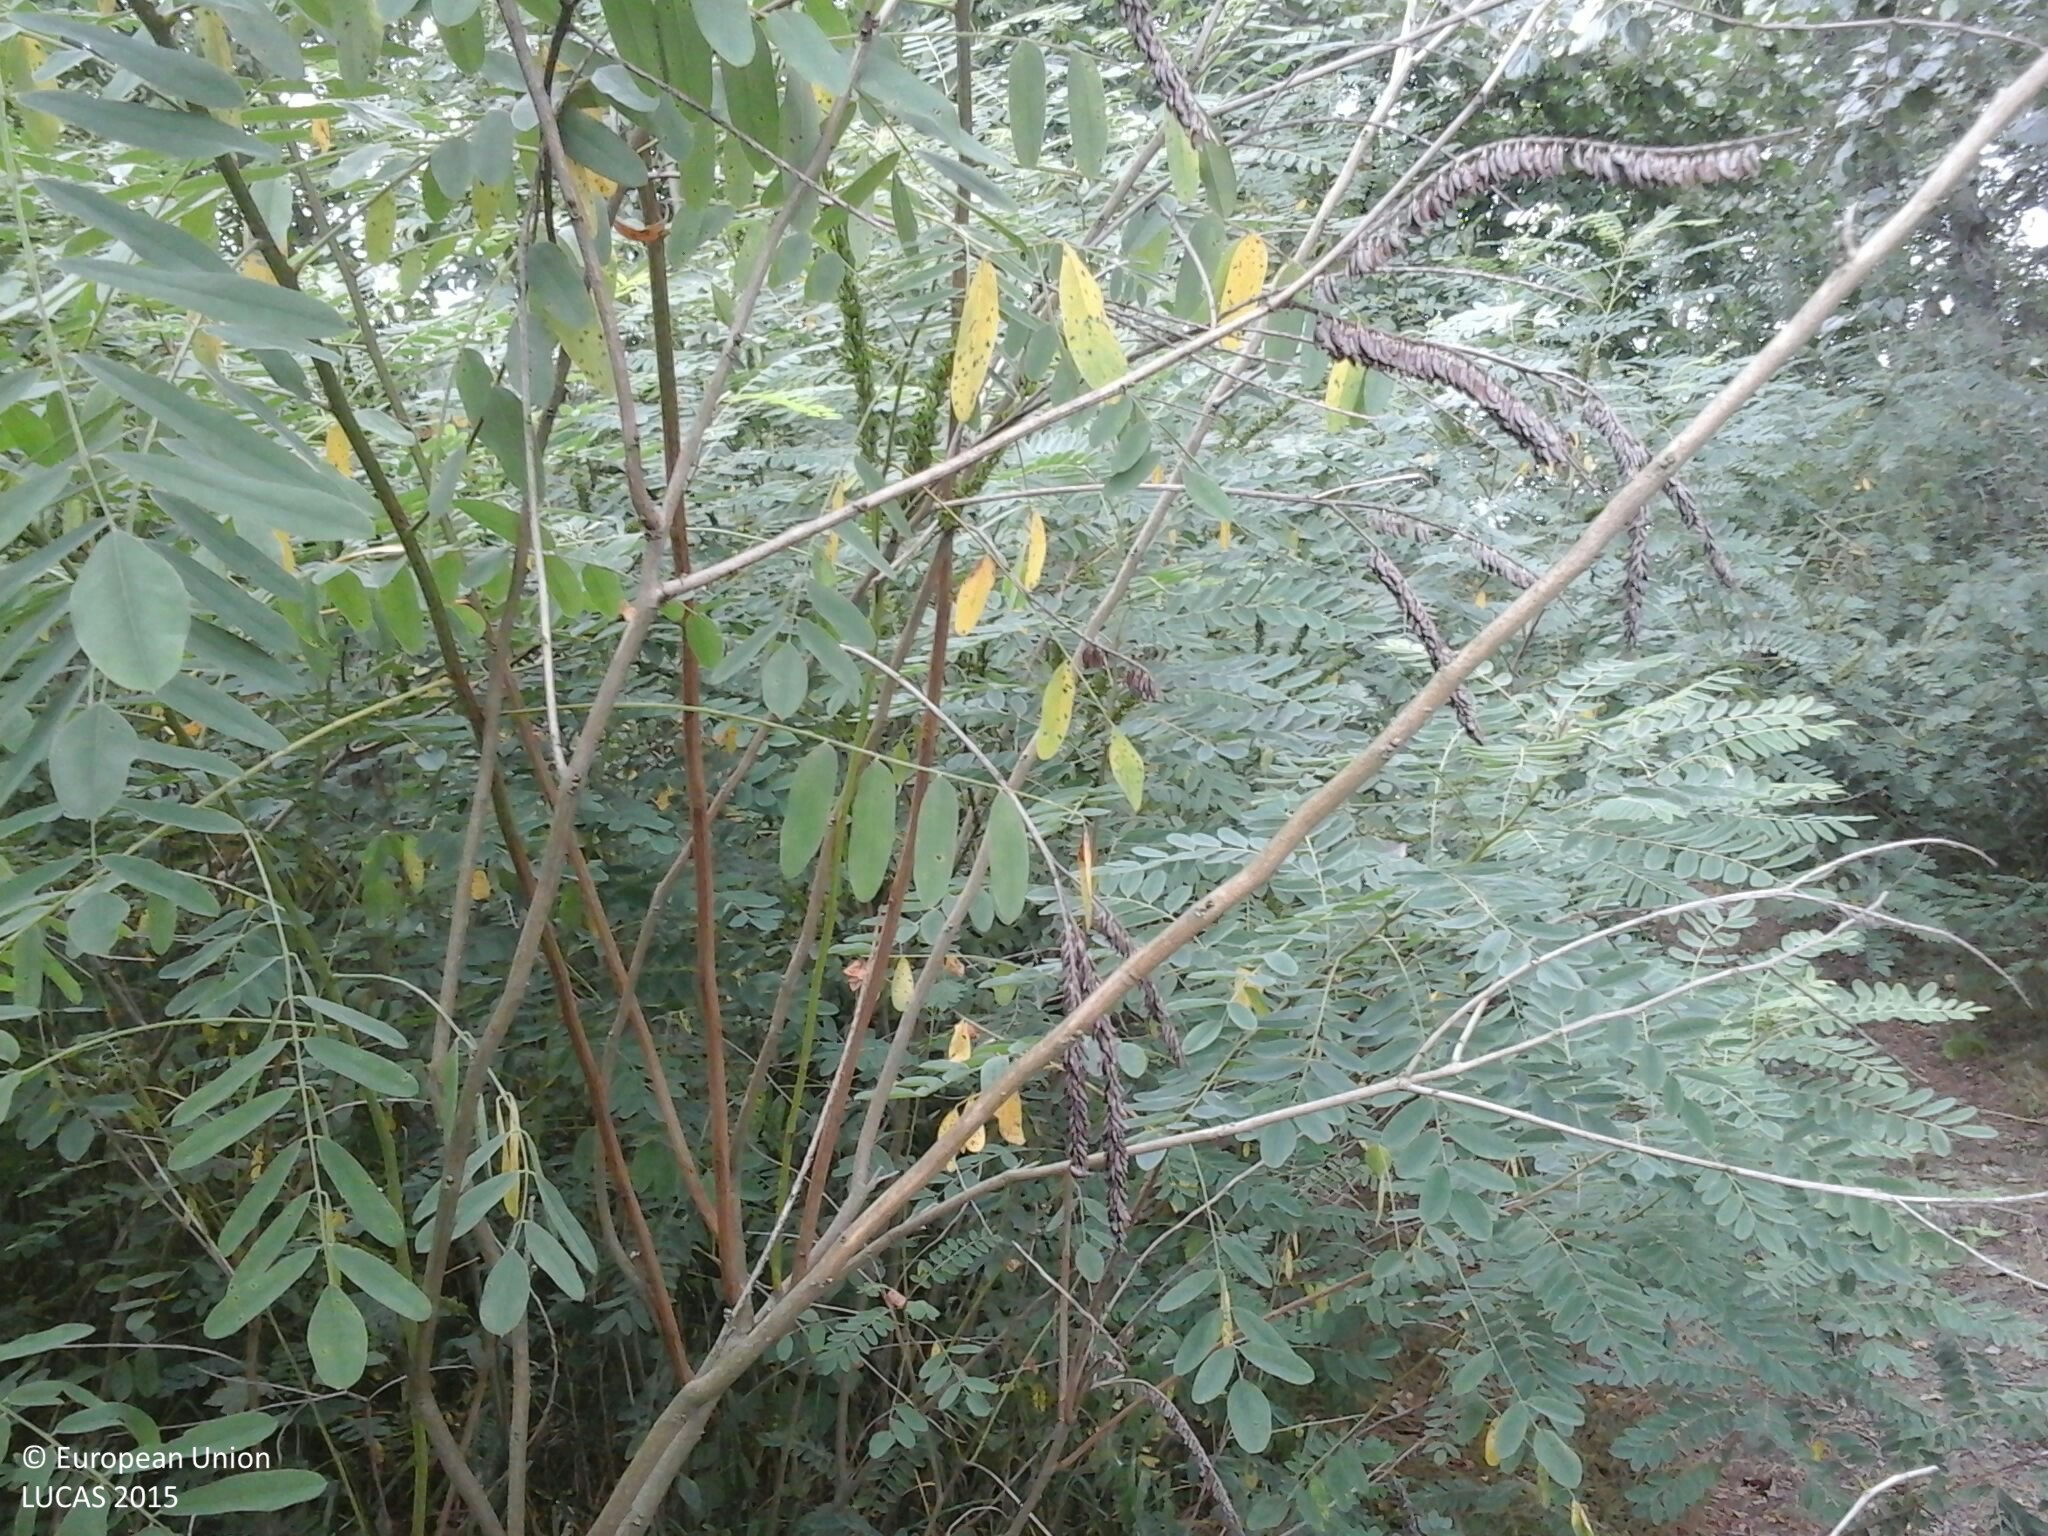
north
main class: Woodland
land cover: Broadleaved woodland
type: floodplain forest
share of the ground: > 75 %
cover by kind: broadleaved forest trees 90 %, shrubs 5 %, herbaceous plants 5 %
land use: Forestry
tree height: < 5 m
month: July
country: HU
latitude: 46.9577
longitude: 20.1302
